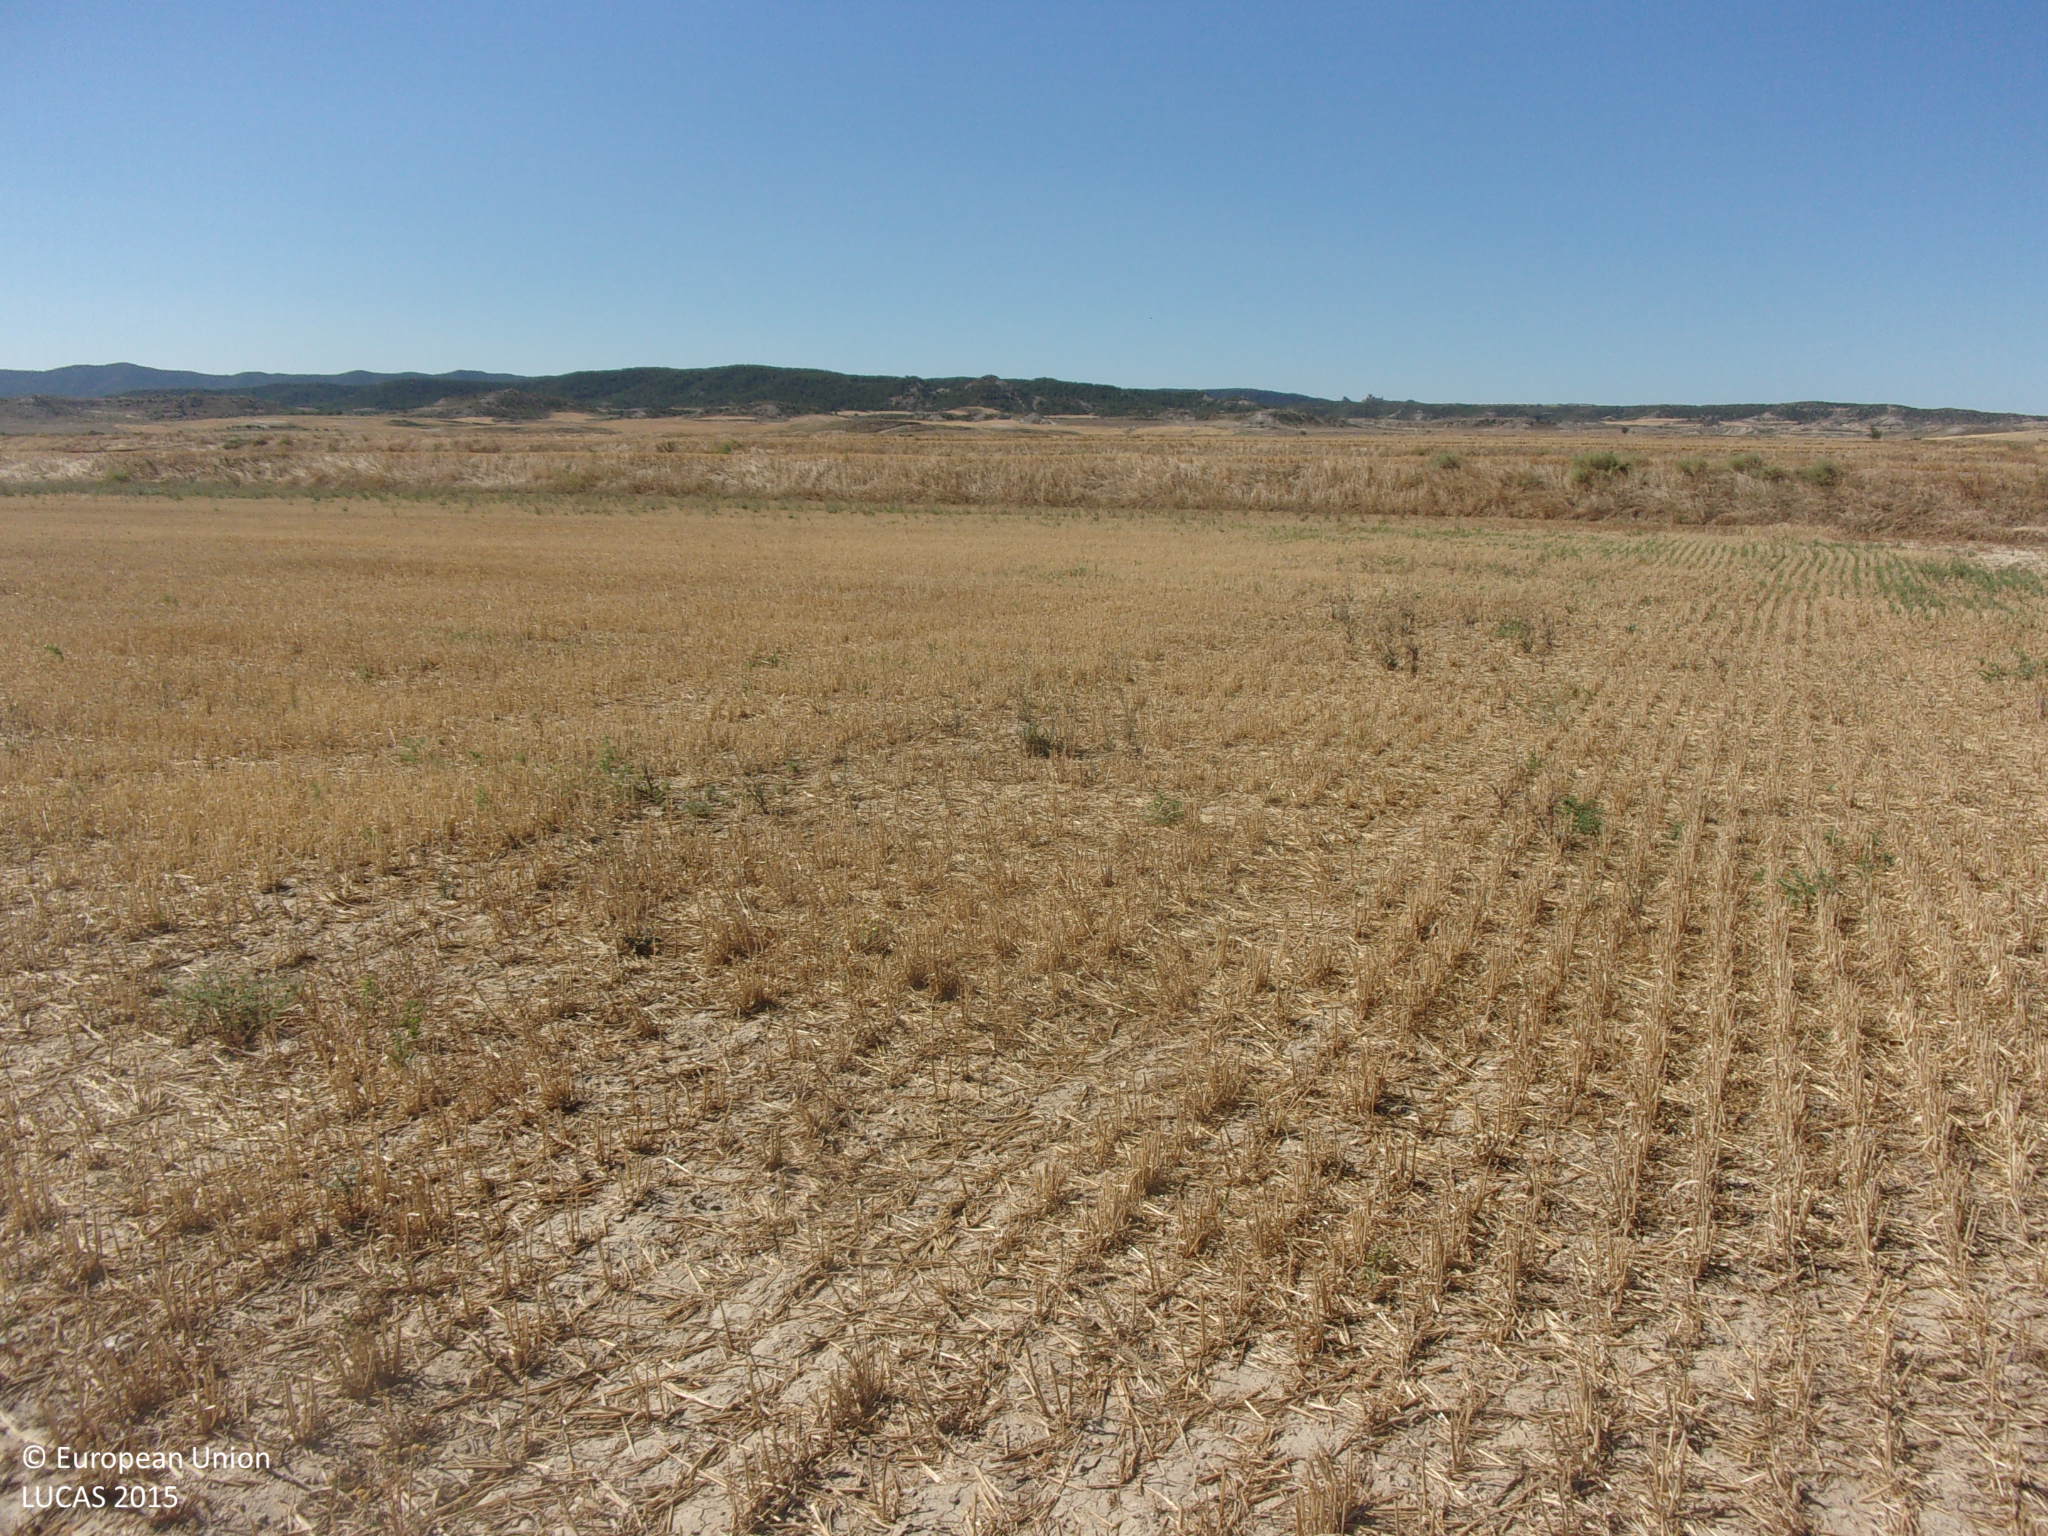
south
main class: Cropland
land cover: Barley
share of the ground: < 10 %
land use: Agriculture (excluding fallow land and kitchen gardens)
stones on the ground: < 10 %
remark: Harvested field
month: July
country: ES
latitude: 42.0851
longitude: -1.0400
